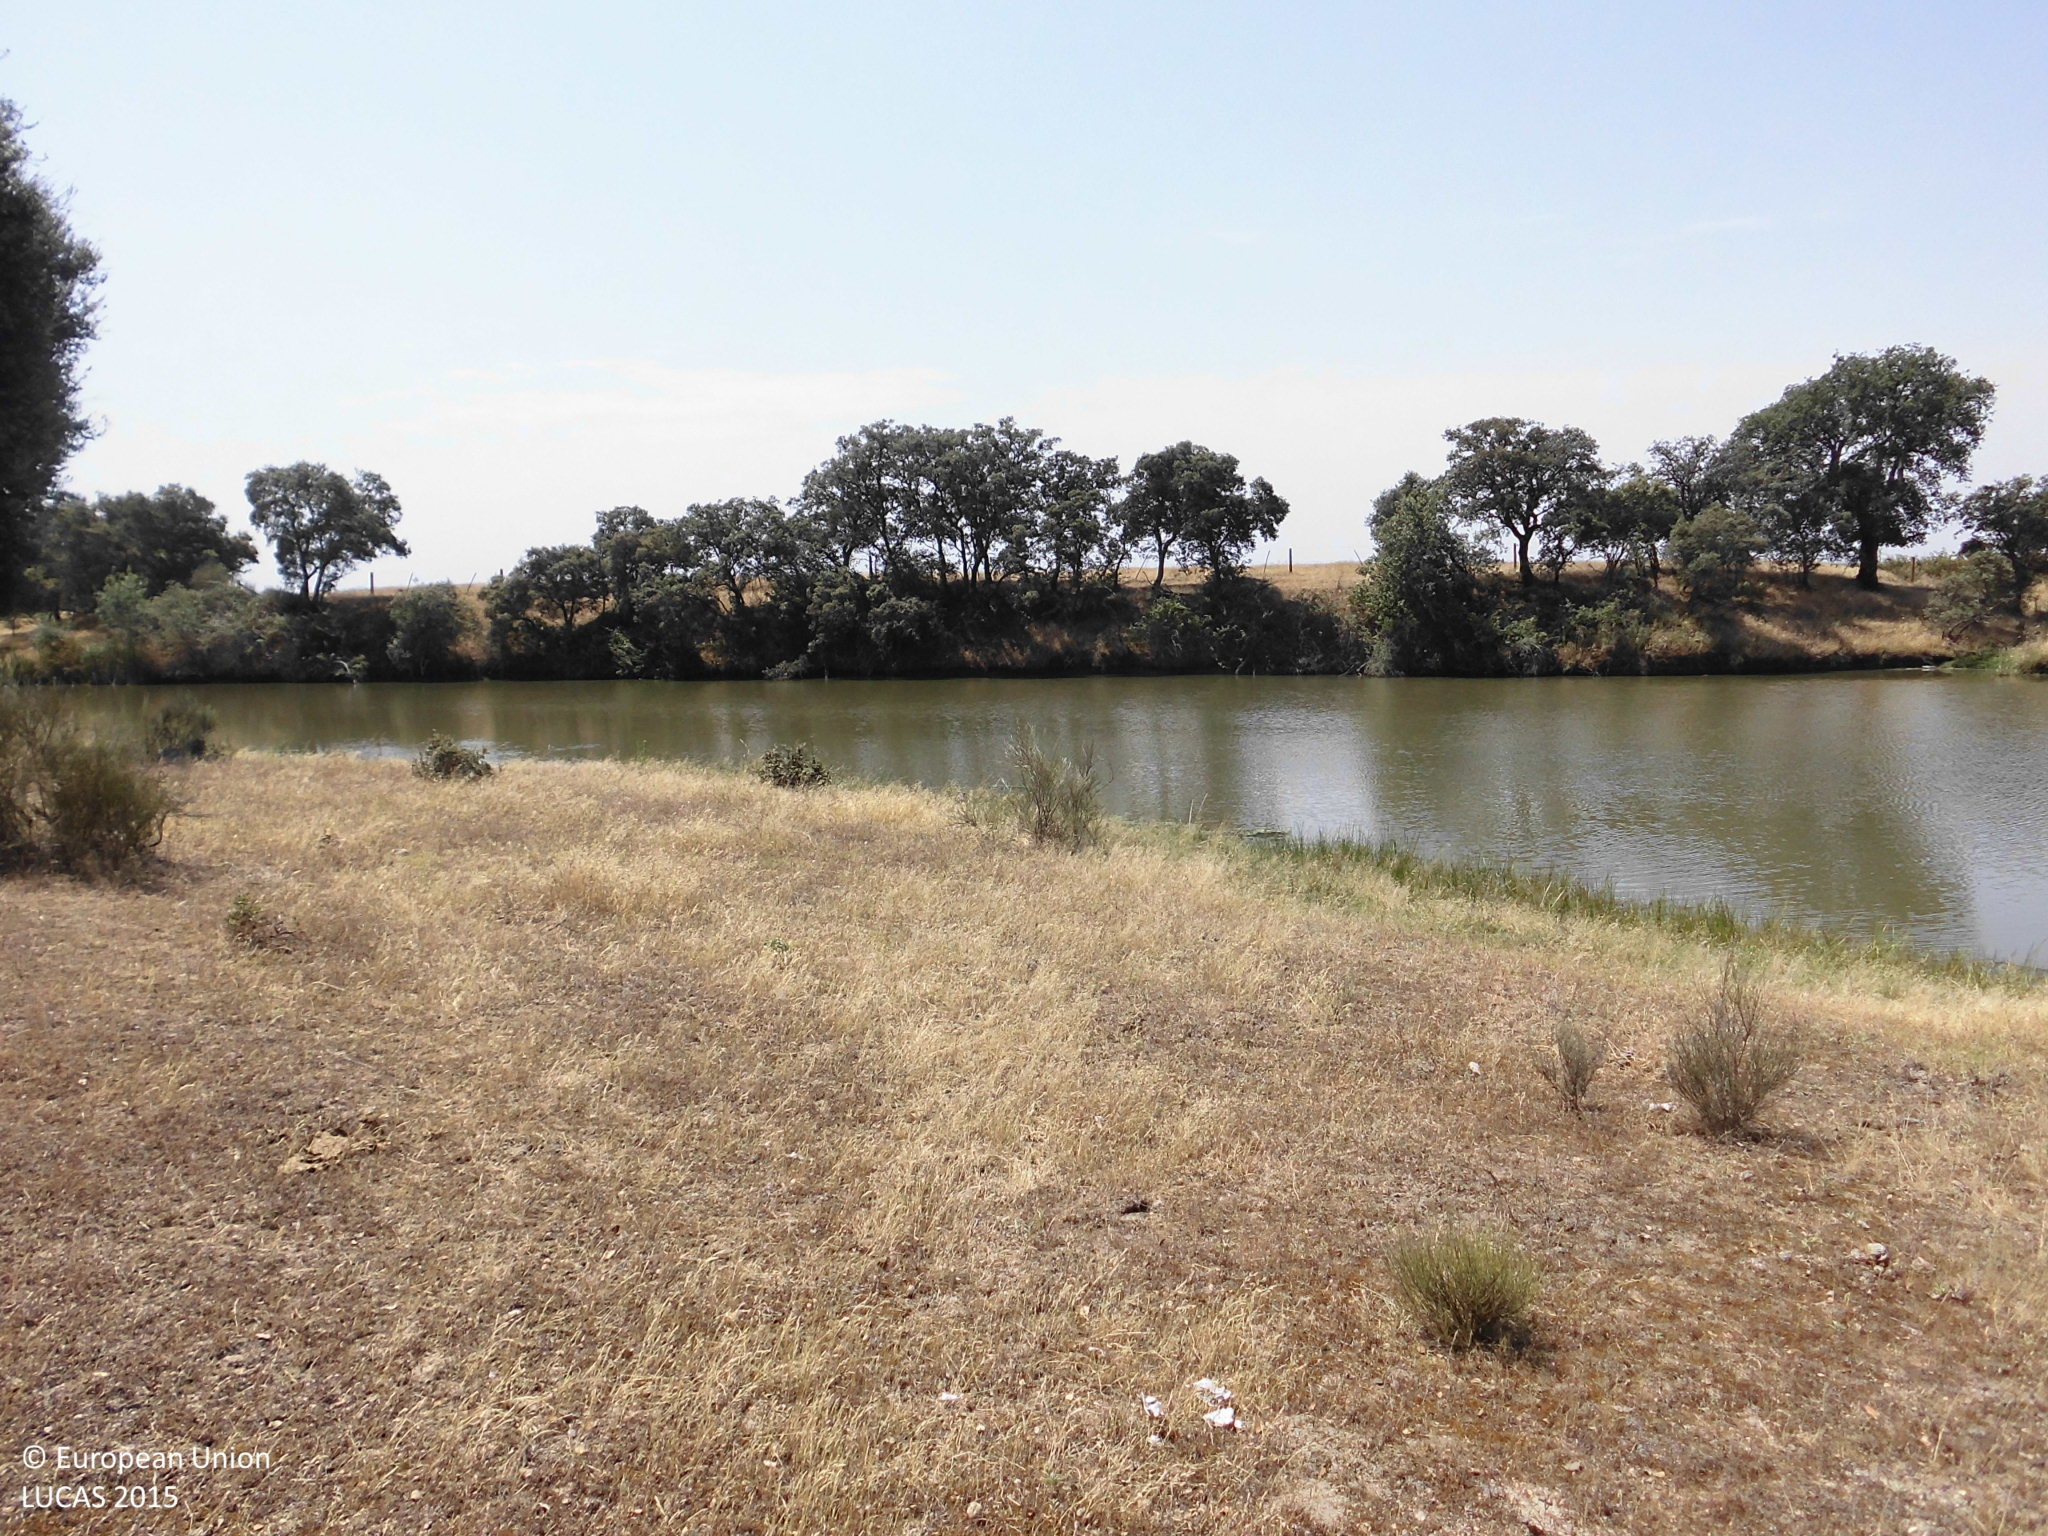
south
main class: Woodland
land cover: Broadleaved woodland
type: broadleaved evergreen forest
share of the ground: 10 - 25 %
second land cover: Grassland without tree/shrub cover
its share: > 75 %
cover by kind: herbaceous plants 80 %, broadleaved forest trees 15 %, consolidated bare surface 5 %
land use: Forestry
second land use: Agriculture (excluding fallow land and kitchen gardens)
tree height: > 5 m
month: June
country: ES
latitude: 39.9032
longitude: -5.6529
